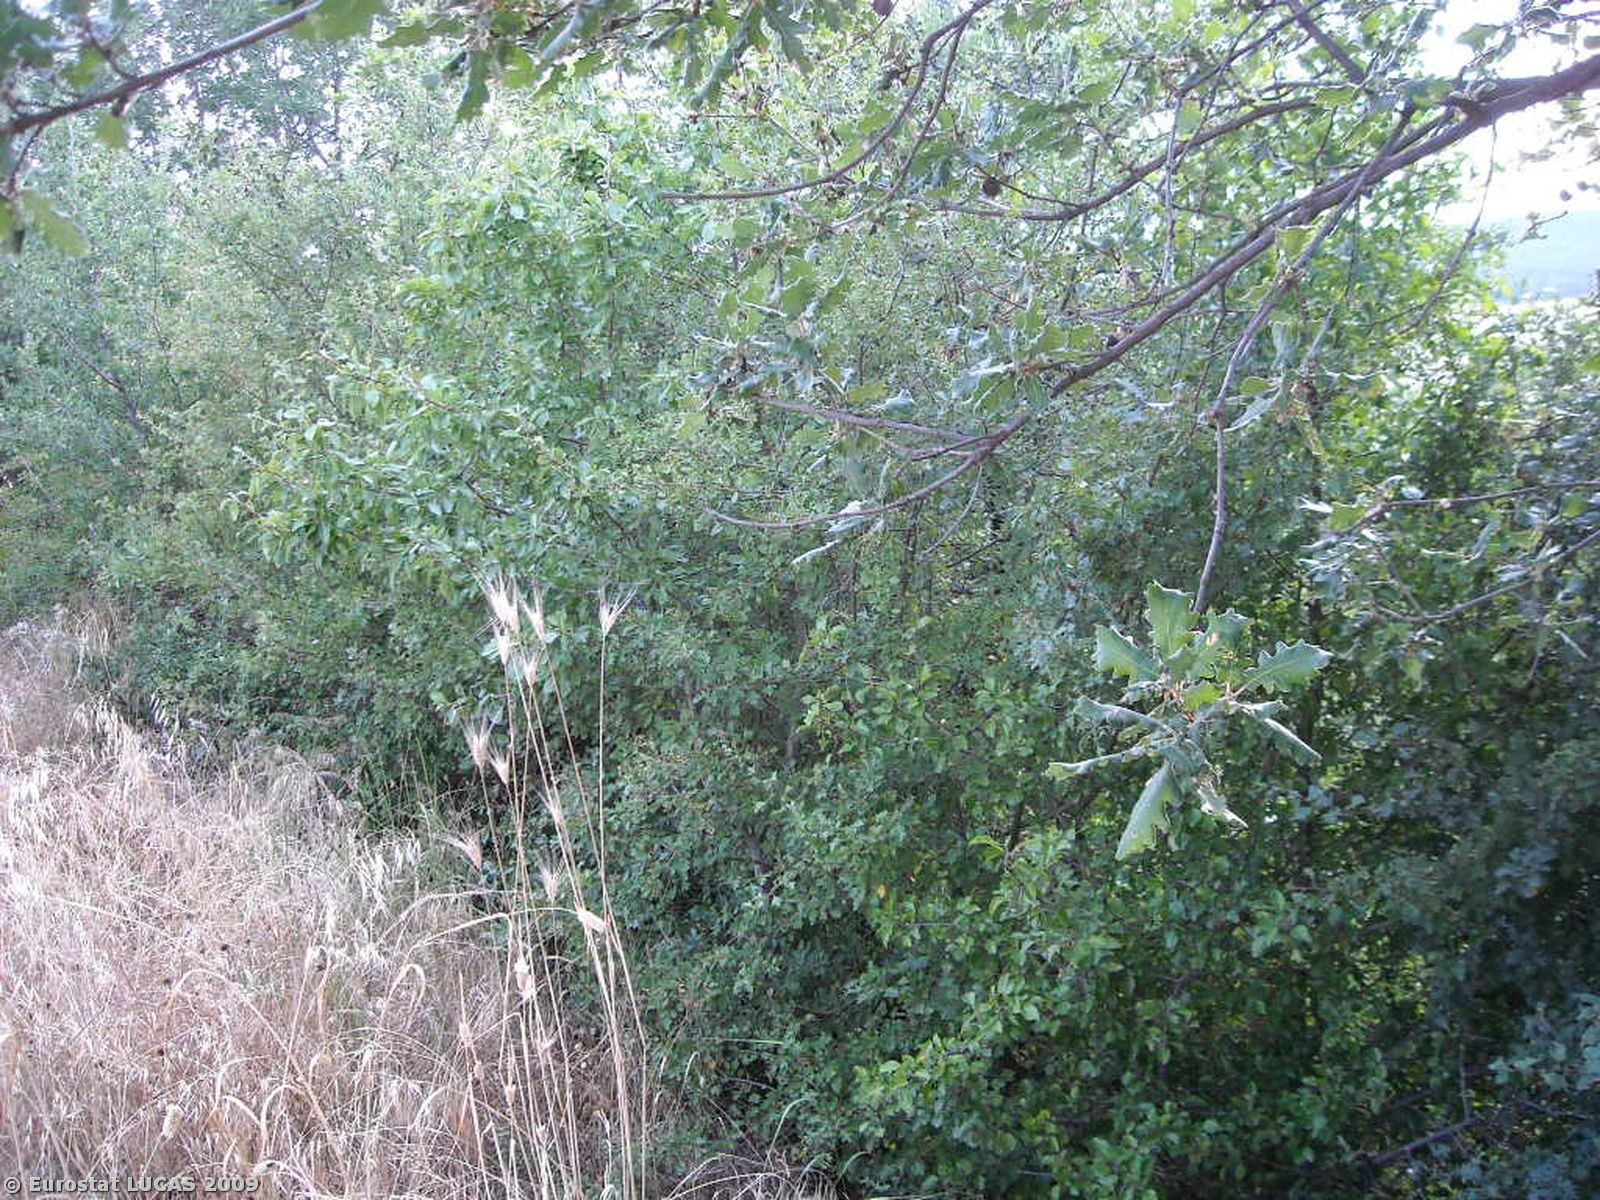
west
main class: Woodland
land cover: Broadleaved woodland
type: thermophilous deciduous forest
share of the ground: > 75 %
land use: Agriculture (excluding fallow land and kitchen gardens)
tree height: > 5 m
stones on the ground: < 10 %
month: July
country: IT
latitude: 40.6555
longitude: 16.1392
